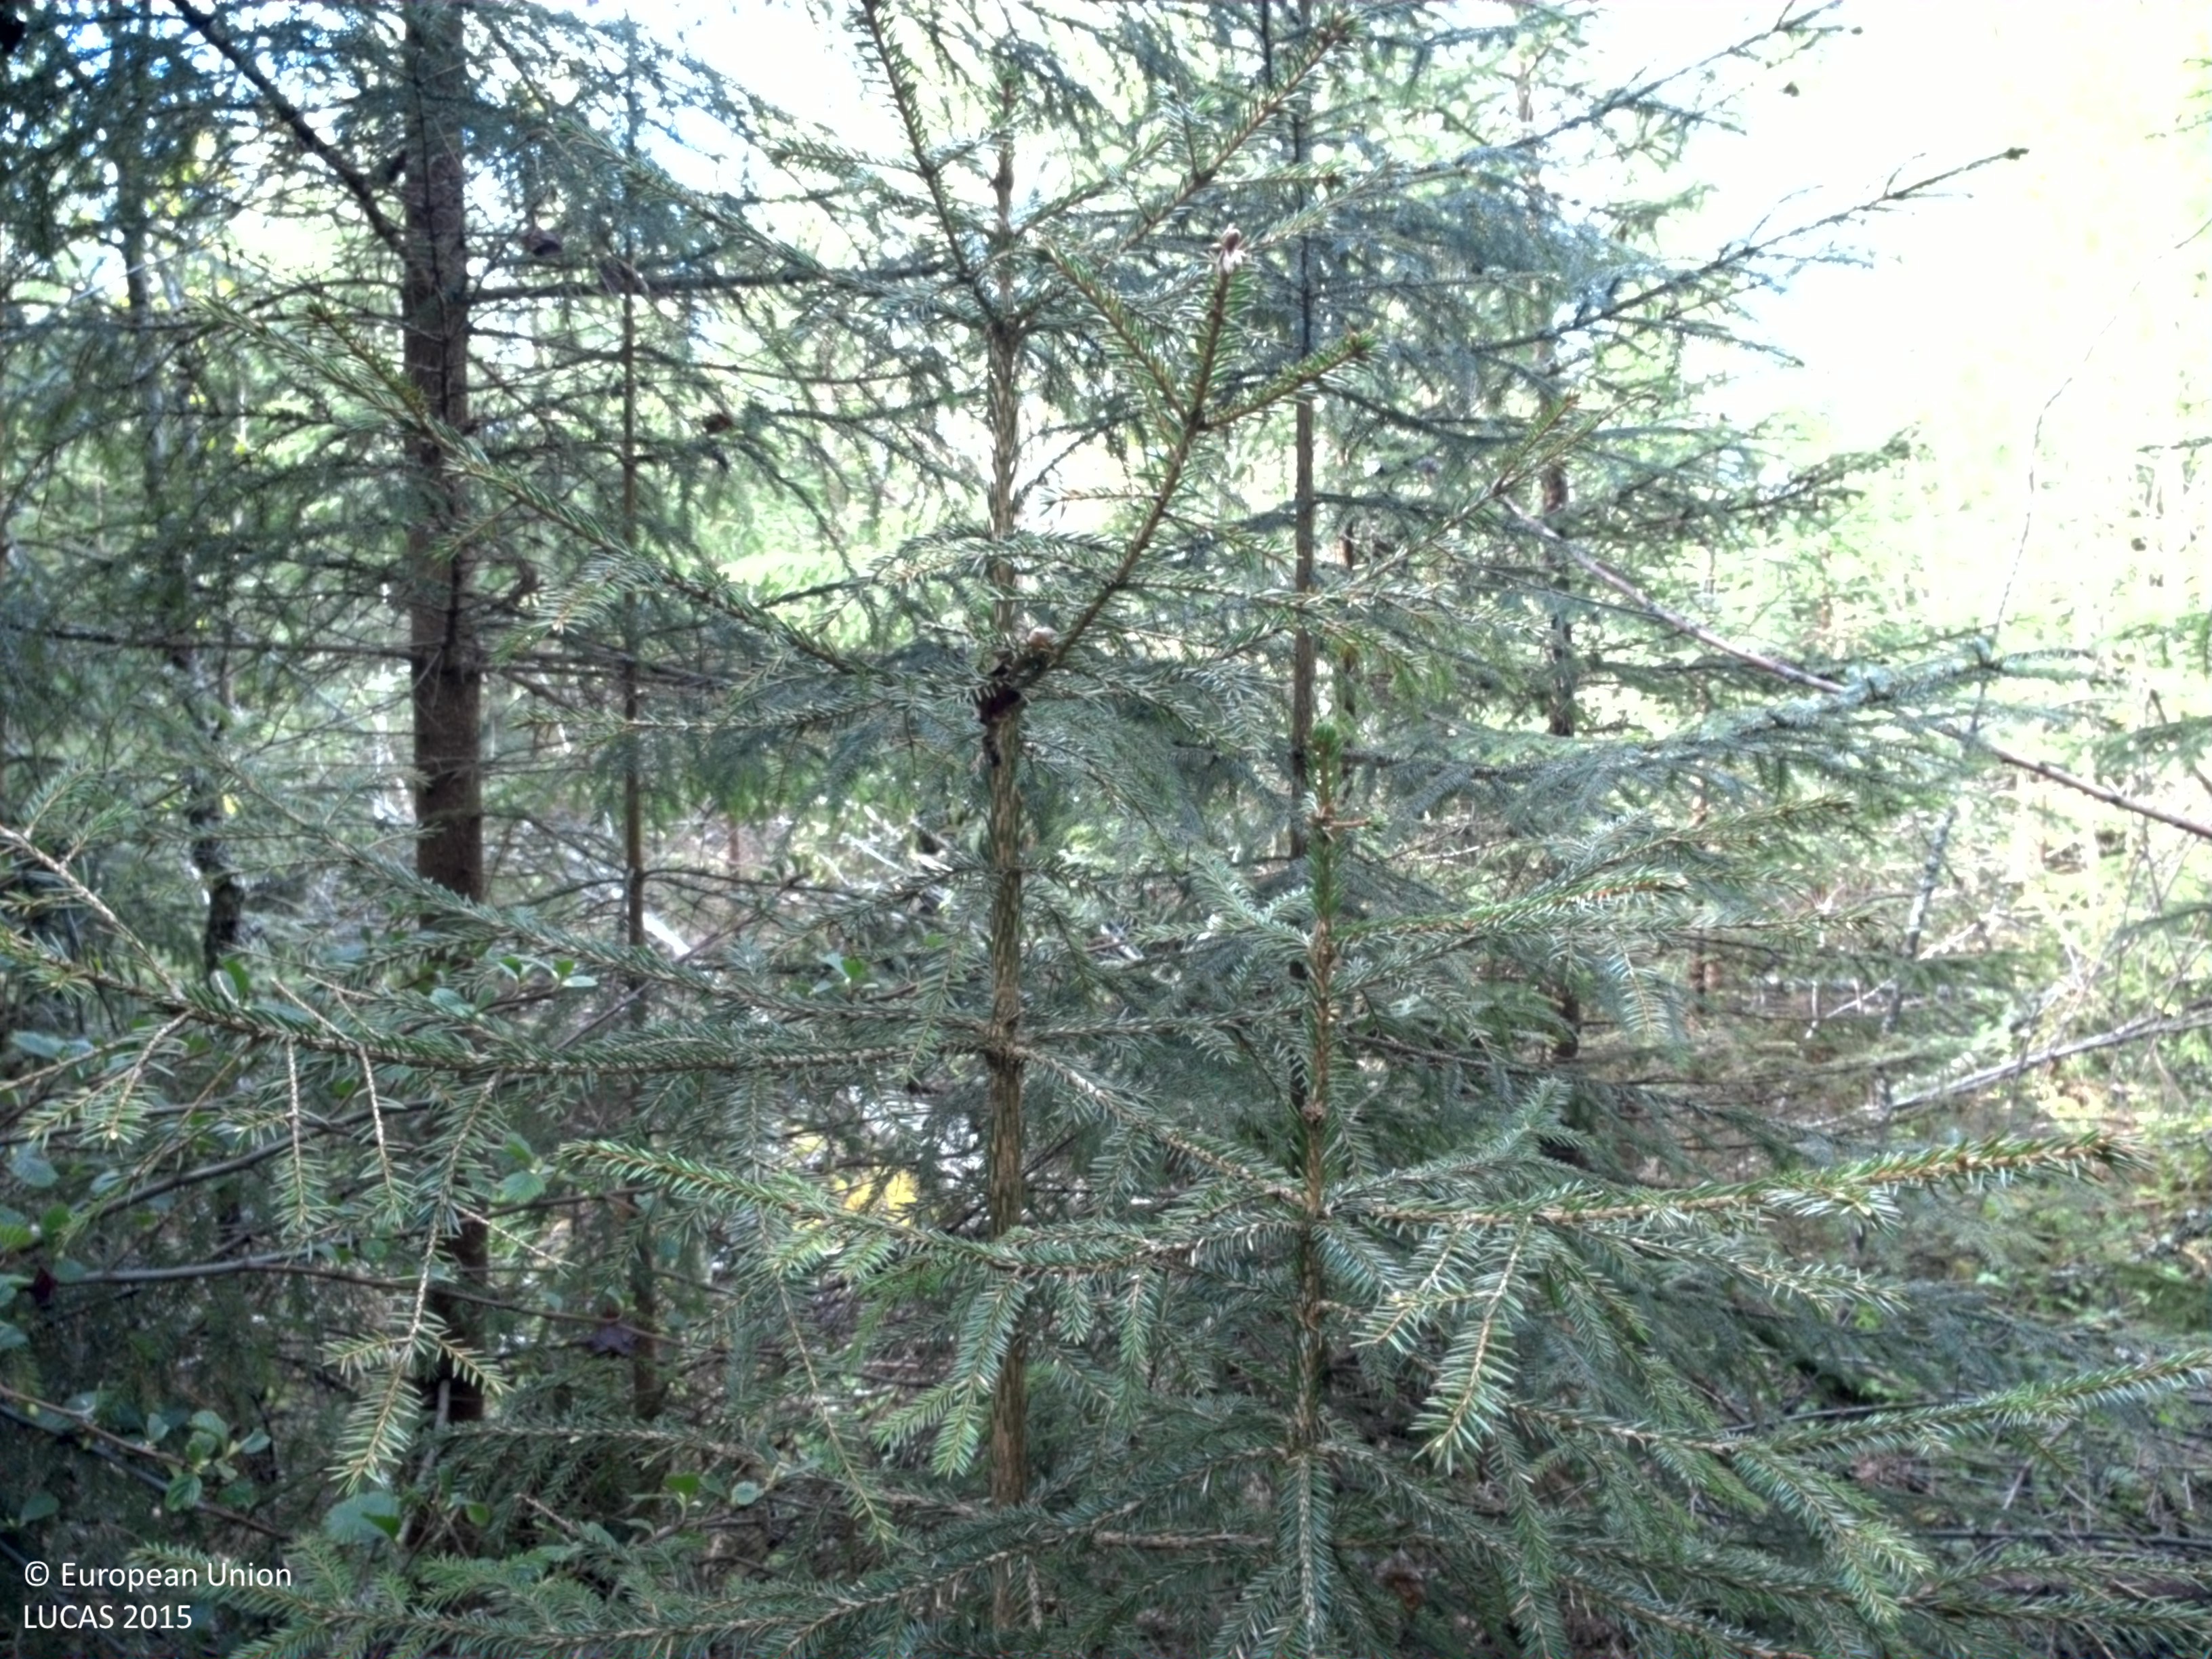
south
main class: Woodland
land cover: Spruce dominated mixed woodland
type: boreal forest
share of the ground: > 75 %
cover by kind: coniferous forest trees 40 %, broadleaved forest trees 35 %, lichens and mosses 15 %, shrubs 5 %, herbaceous plants 5 %
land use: Forestry
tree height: > 5 m
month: May
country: SE
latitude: 57.4077
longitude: 15.4065
